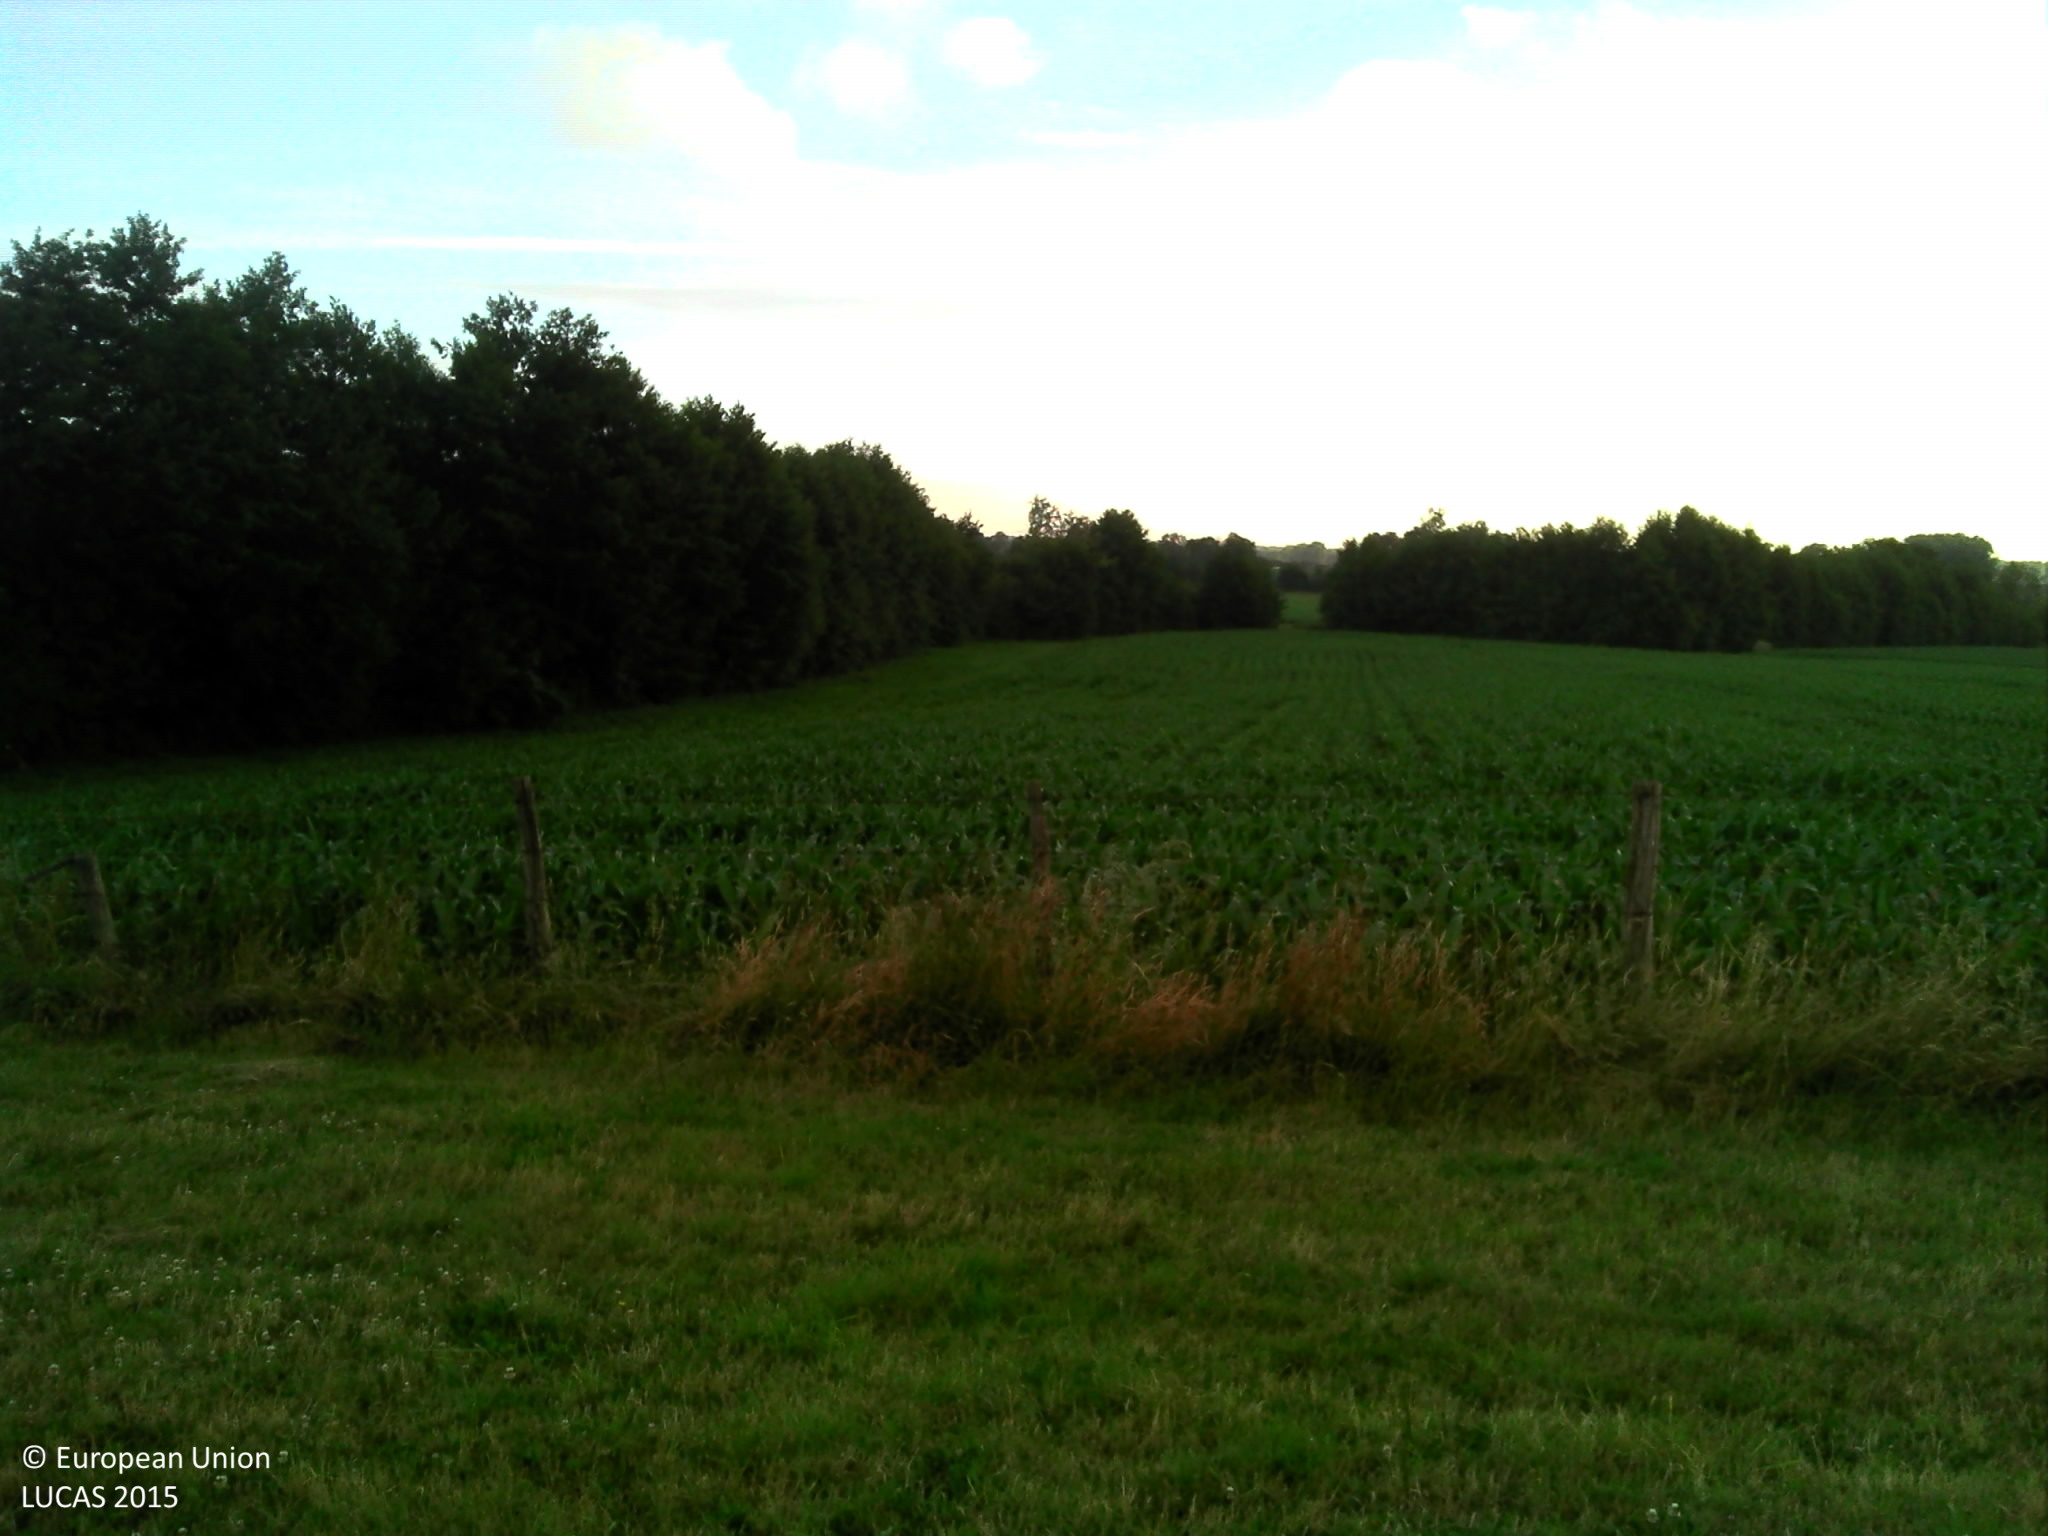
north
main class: Grassland
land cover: Grassland without tree/shrub cover
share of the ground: > 75 %
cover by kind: herbaceous plants 100 %
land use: Agriculture (excluding fallow land and kitchen gardens)
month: June
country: FR
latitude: 47.9708
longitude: -1.4434
